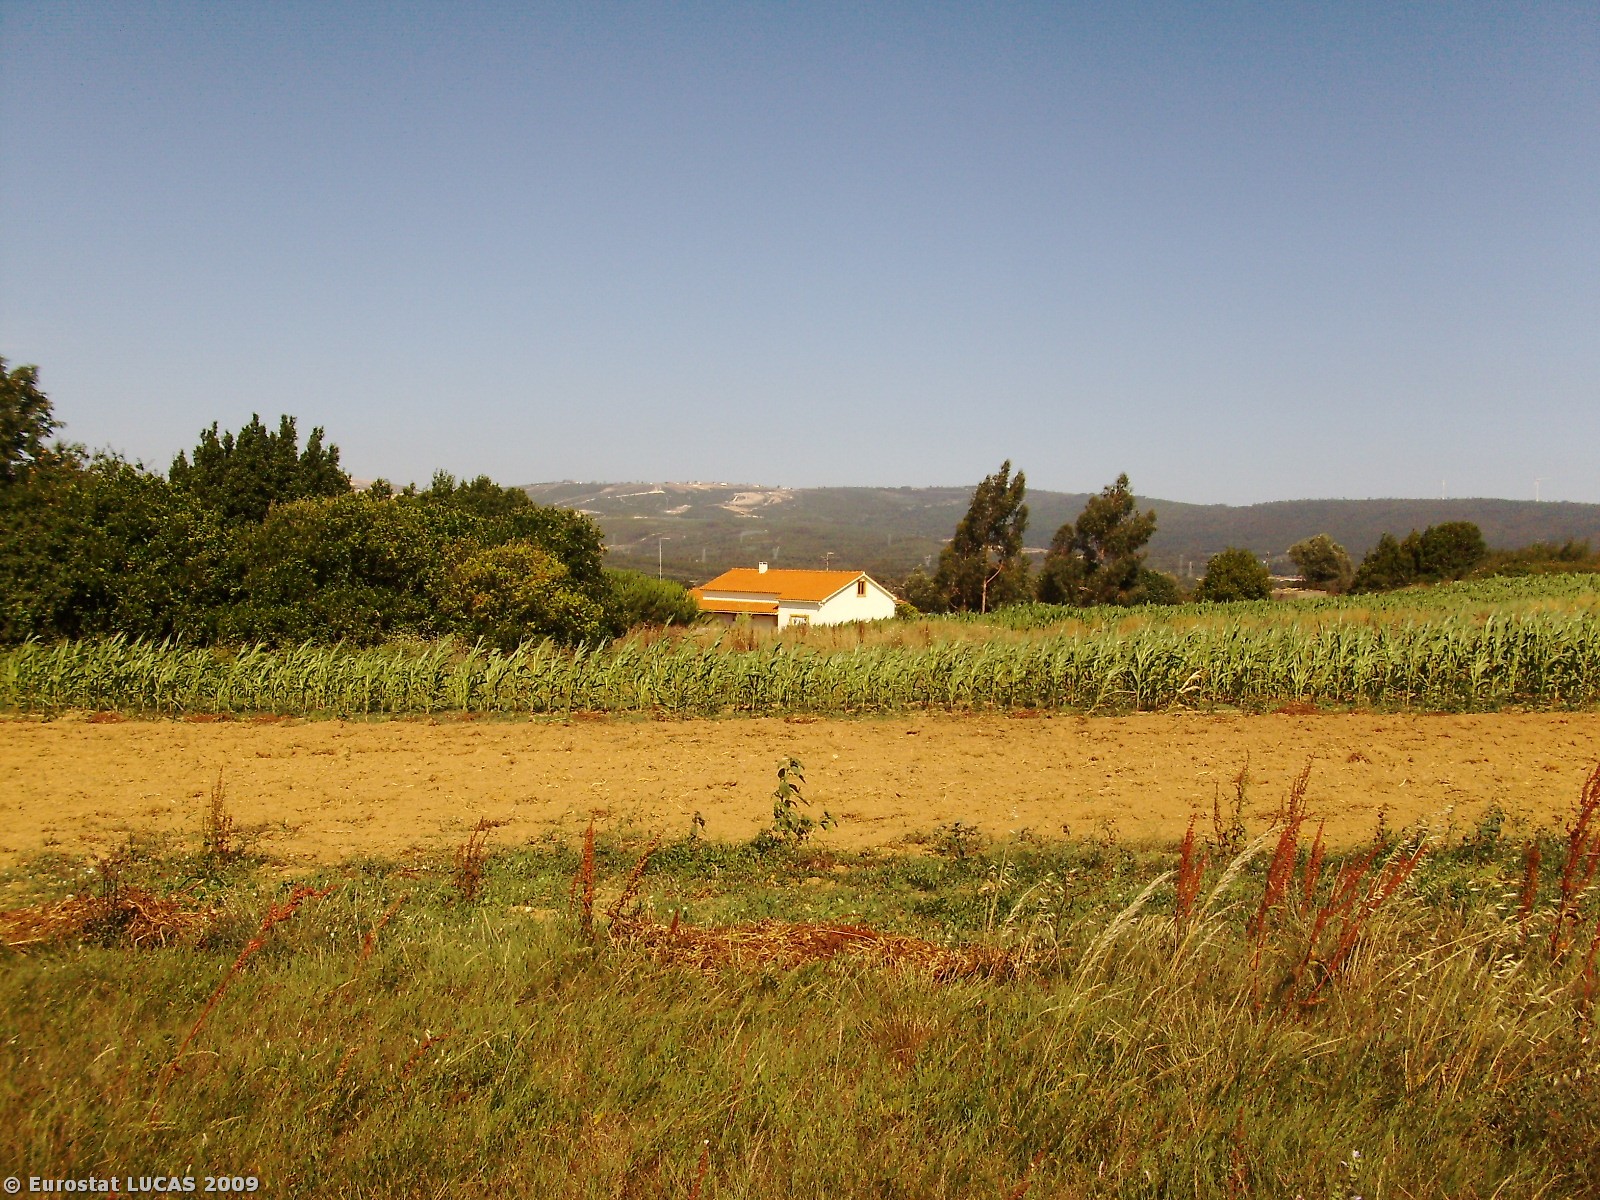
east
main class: Grassland
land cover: Spontaneously vegetated surfaces
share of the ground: > 75 %
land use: Fallow land
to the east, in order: Spontaneously vegetated surfaces; Potatoes; Maize; Shrubland without tree cover; Dry stone walls; Potatoes; Spontaneously vegetated surfaces; Maize; Shrubland without tree cover; Dry stone walls; Spontaneously vegetated surfaces; Artificial constructions in urban areas; Arable land (only in case pi); Dry stone walls; Spontaneously vegetated surfaces
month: July
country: PT
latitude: 39.4708
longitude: -8.9746
